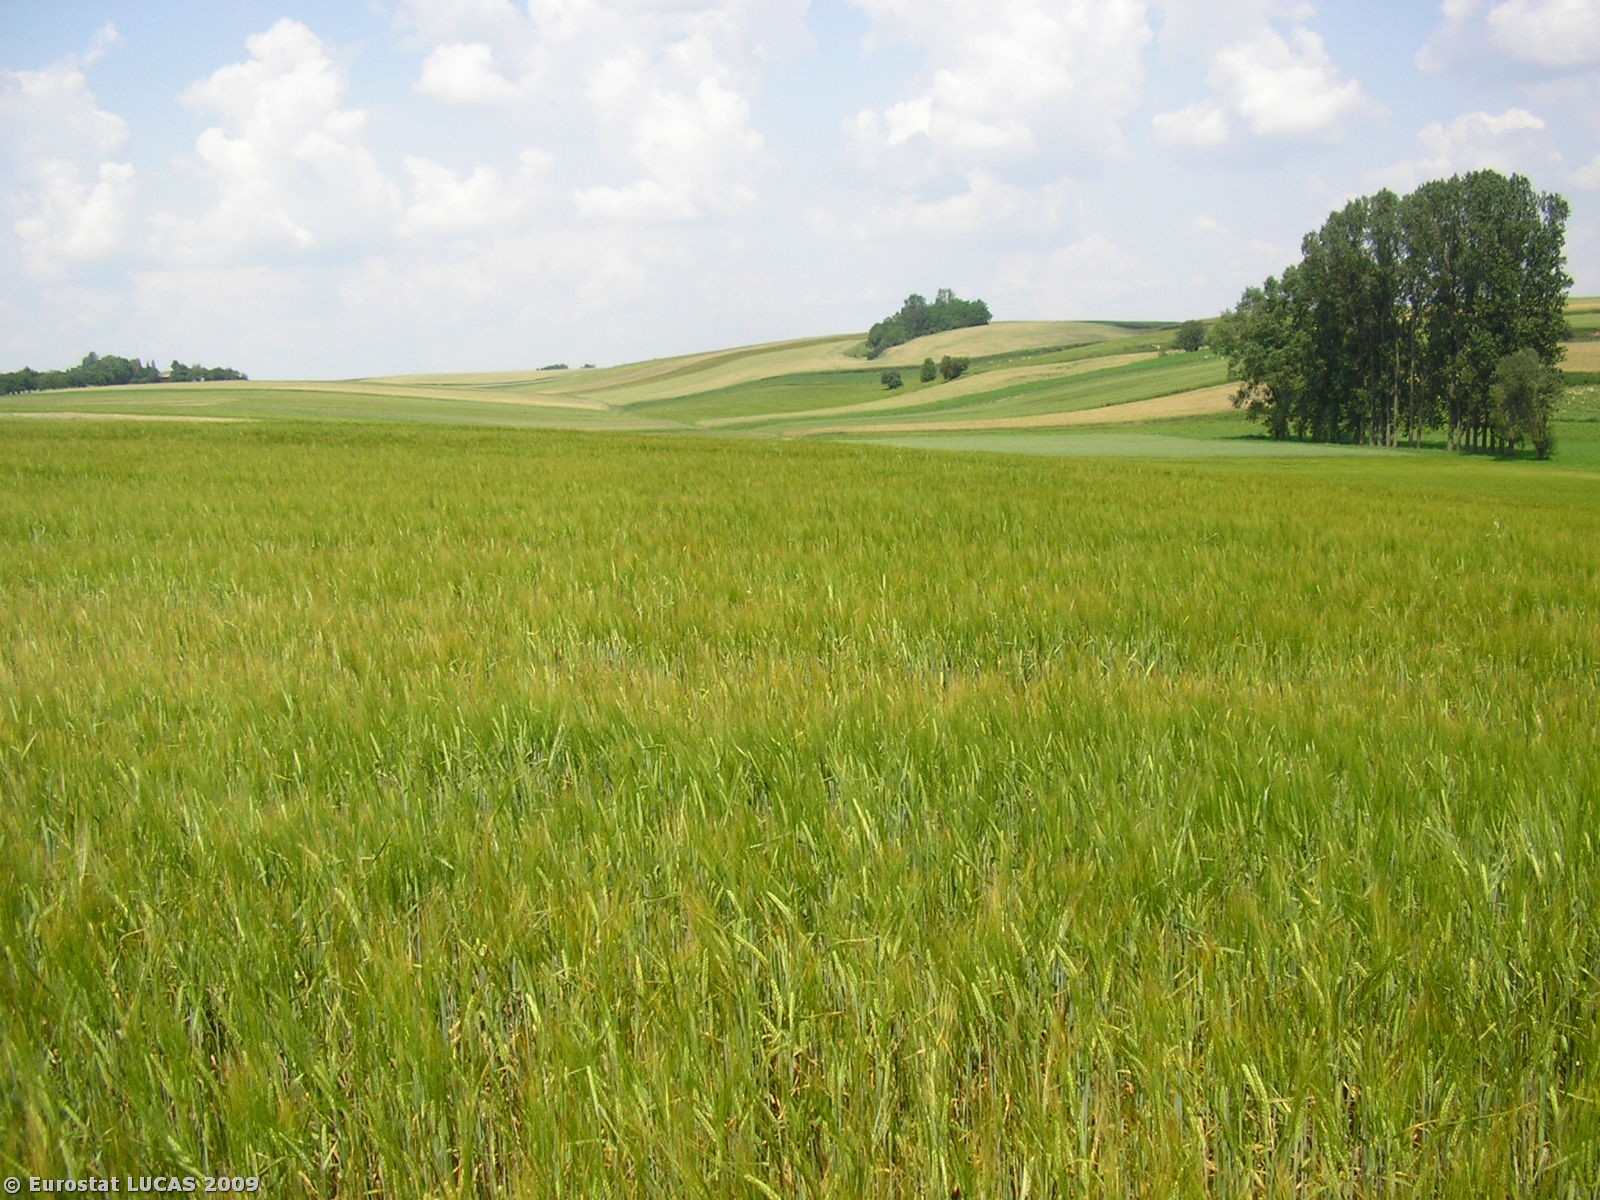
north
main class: Cropland
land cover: Barley
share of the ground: > 75 %
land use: Agriculture (excluding fallow land and kitchen gardens)
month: June
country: PL
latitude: 50.3782
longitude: 20.4005
